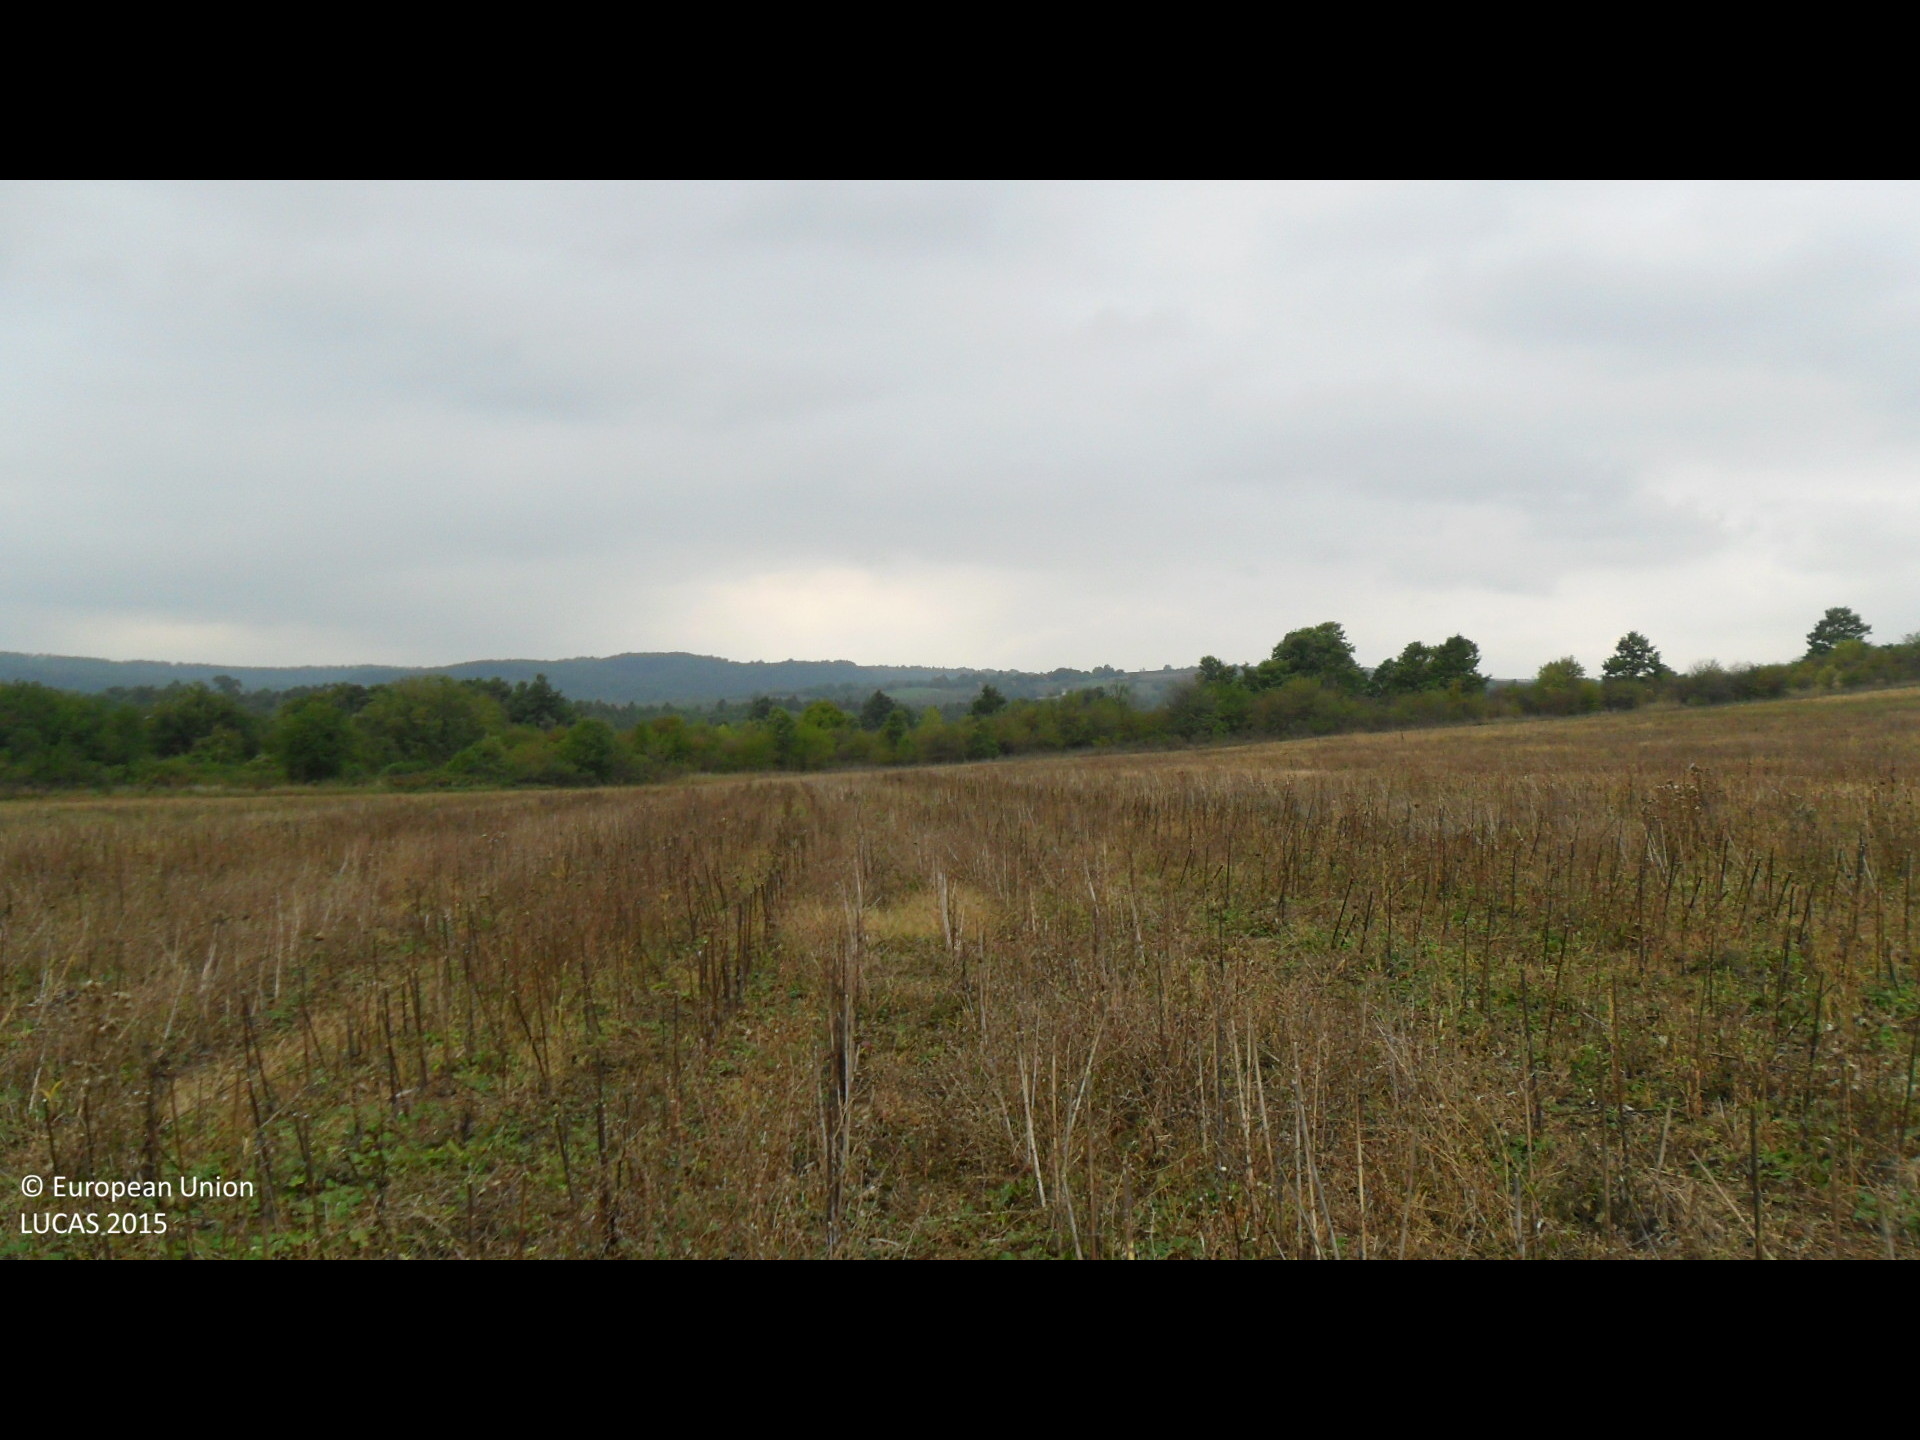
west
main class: Cropland
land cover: Sunflower
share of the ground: 10 - 25 %
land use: Agriculture (excluding fallow land and kitchen gardens)
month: September
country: BG
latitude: 43.1488
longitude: 26.2646
